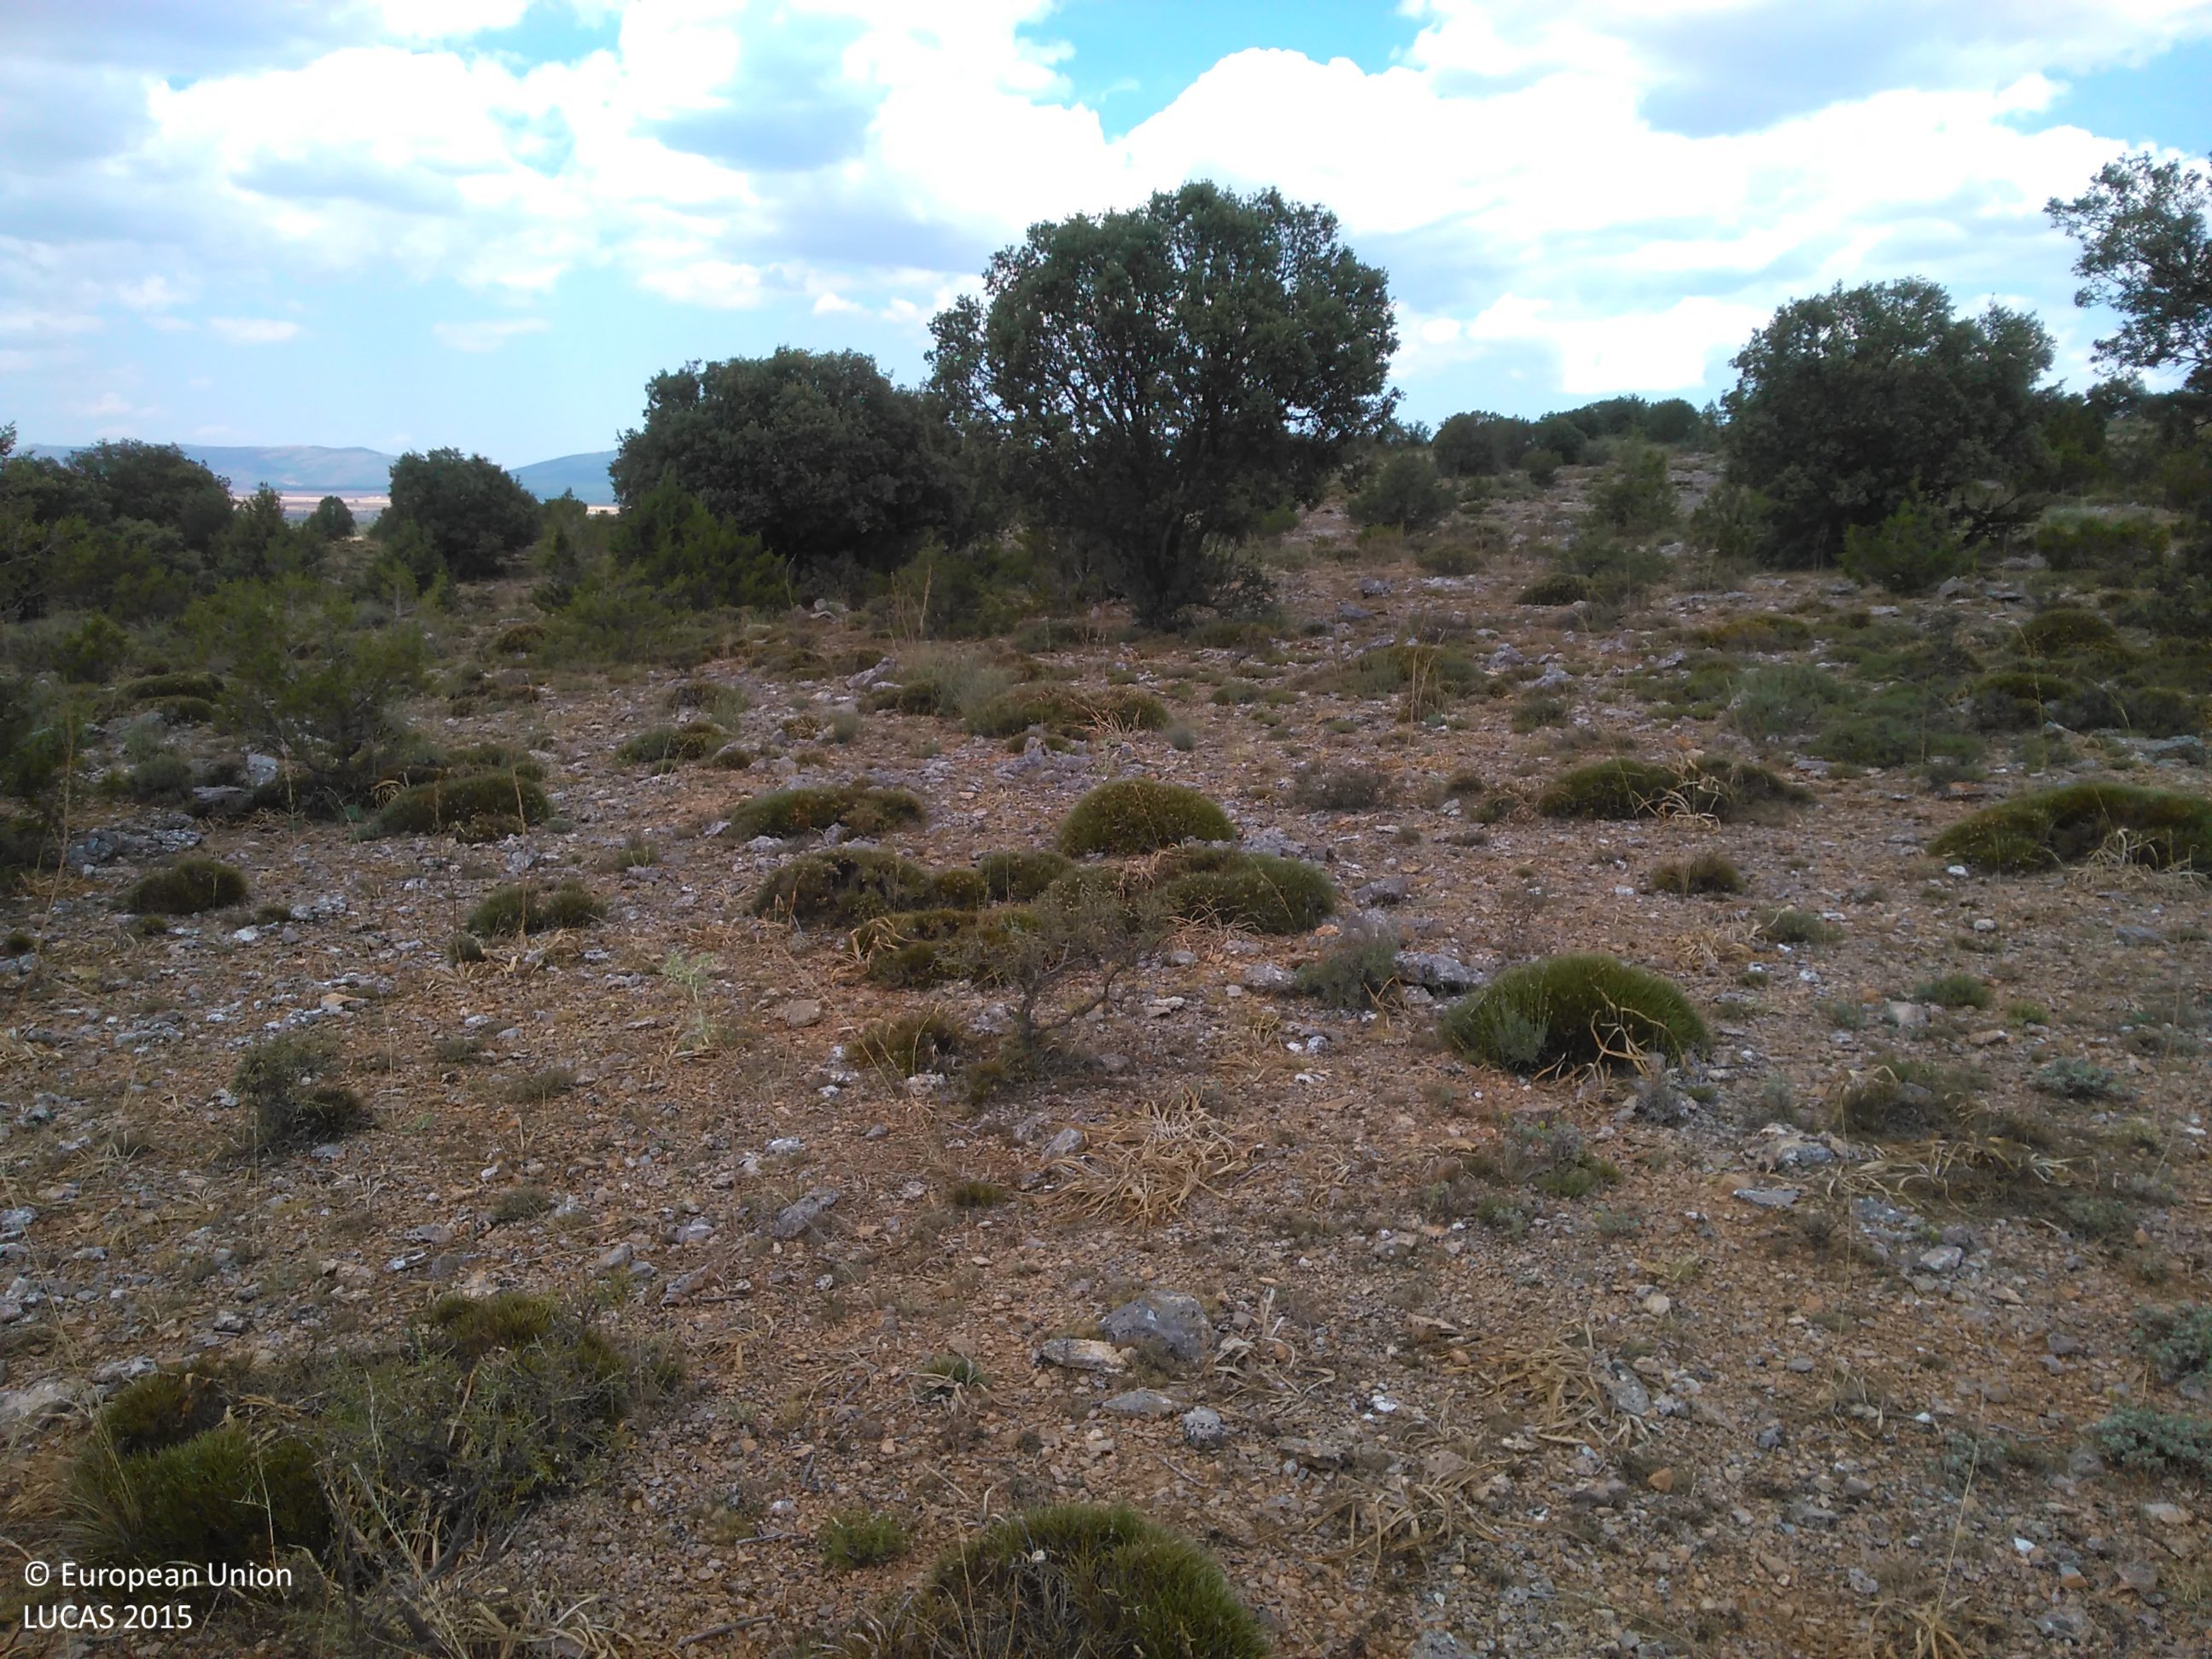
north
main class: Shrubland
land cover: Shrubland with sparse tree cover
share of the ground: 25 - 50 %
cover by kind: unconsolidated bare surface 50 %, shrubs 35 %, herbaceous plants 10 %, broadleaved forest trees 5 %
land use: Semi-natural and natural areas not in use
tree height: < 5 m
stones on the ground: > 50 %
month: July
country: ES
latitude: 41.6186
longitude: -1.9240
